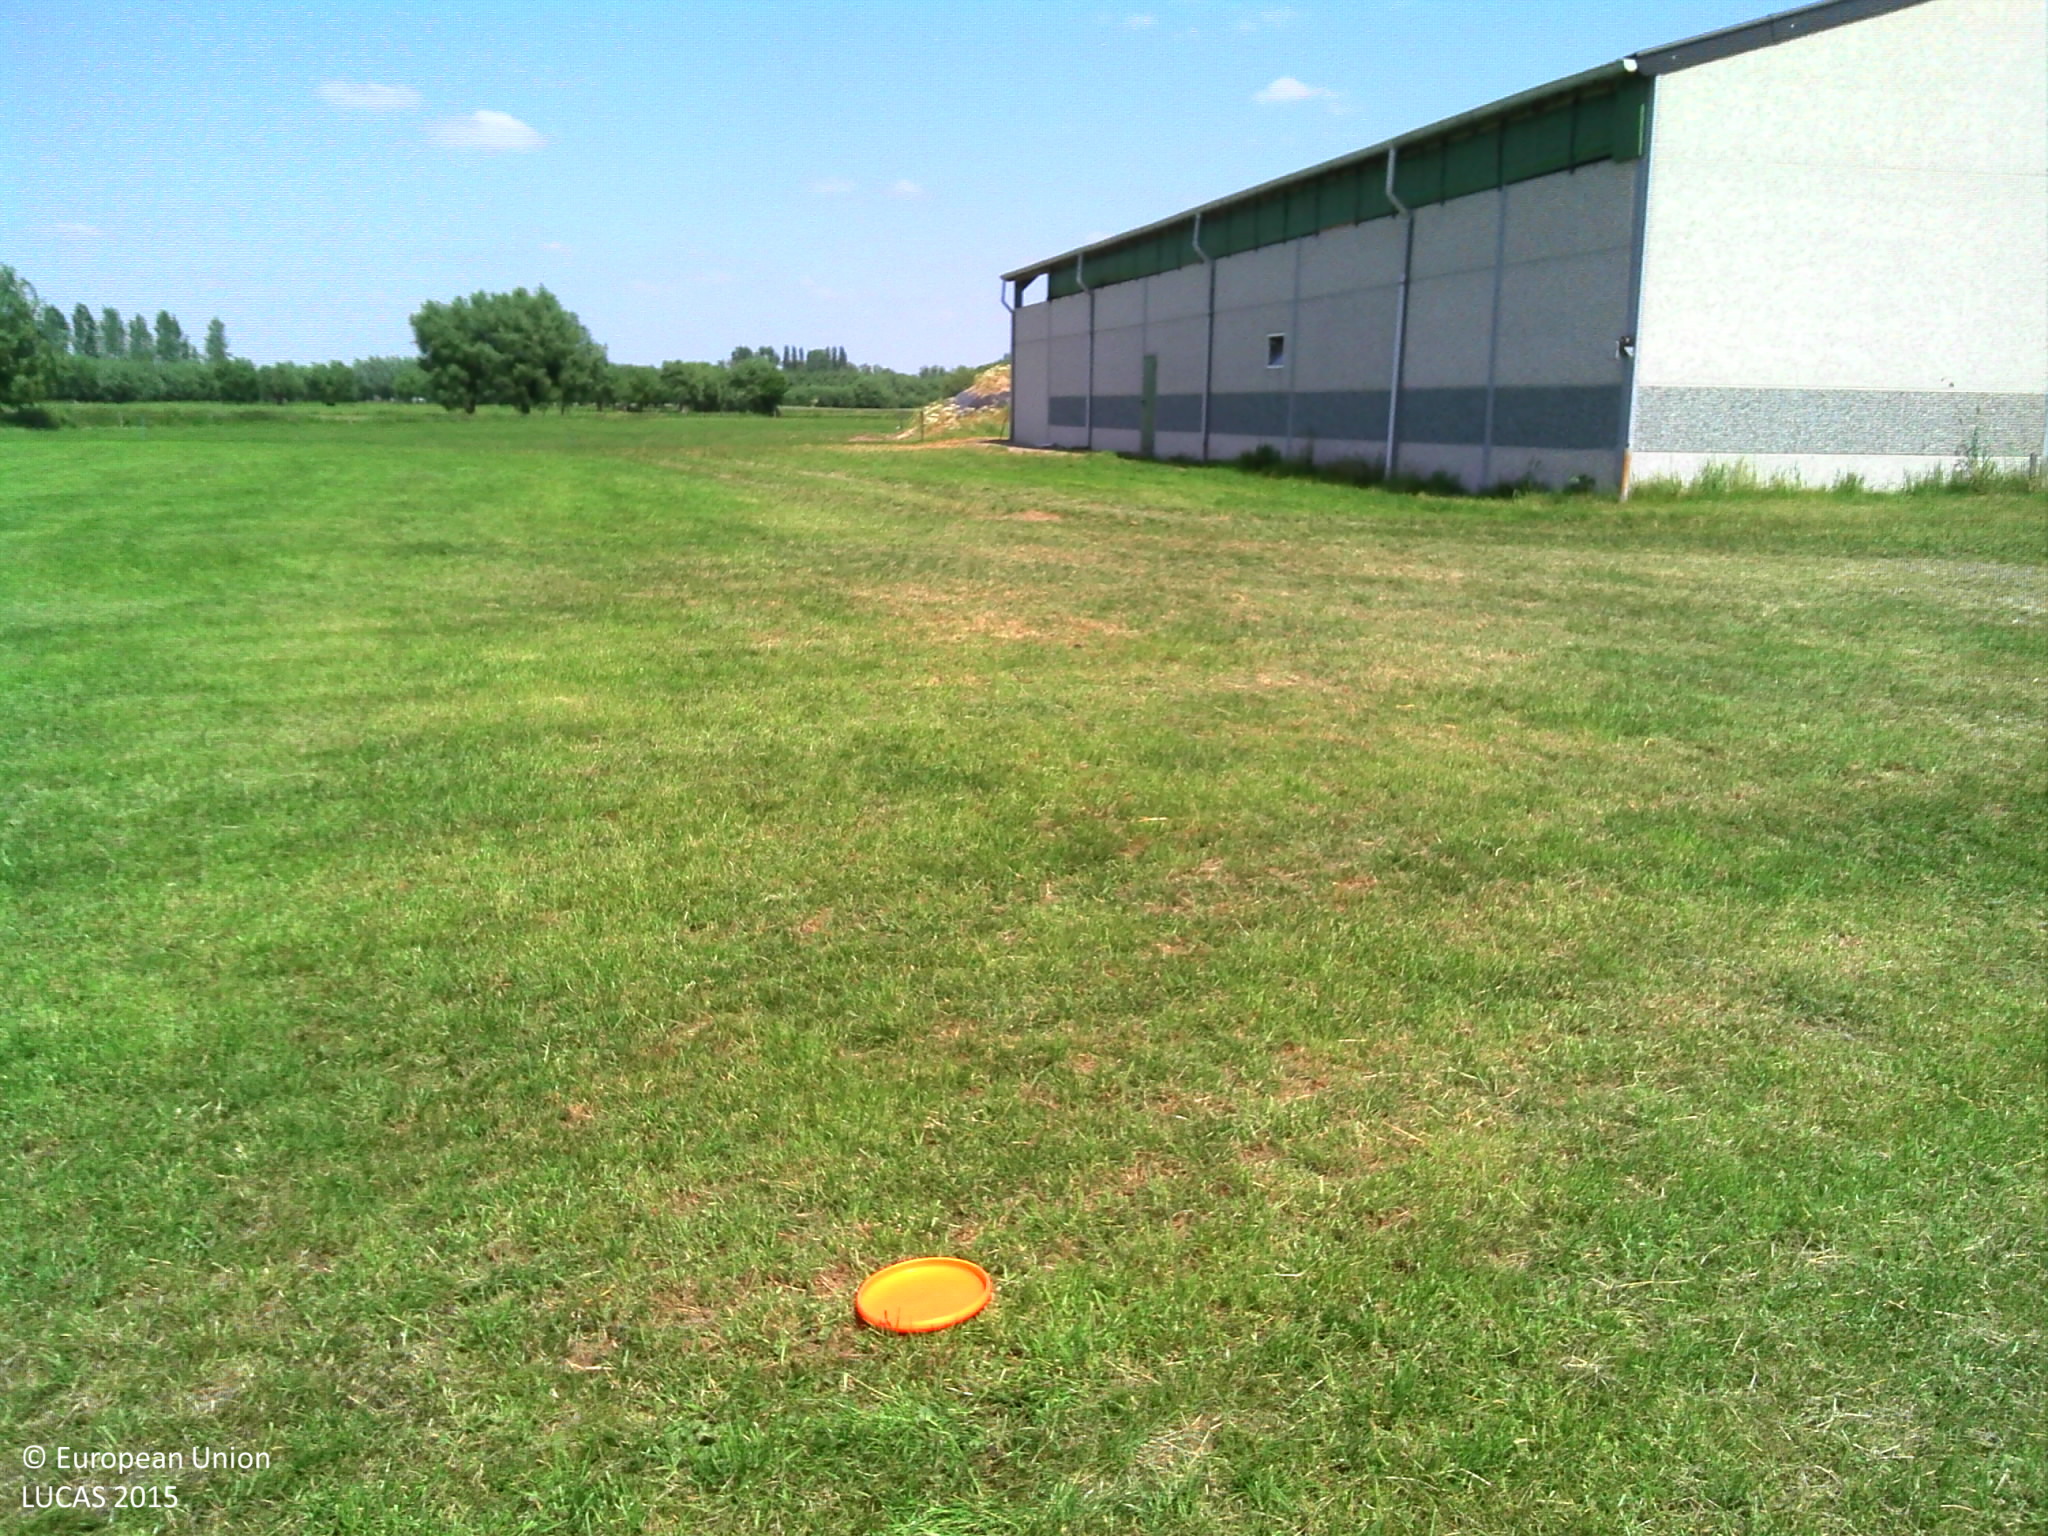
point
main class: Grassland
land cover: Grassland without tree/shrub cover
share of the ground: > 75 %
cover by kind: herbaceous plants 100 %
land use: Agriculture (excluding fallow land and kitchen gardens)
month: June
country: BE
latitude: 51.0727
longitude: 4.0142
